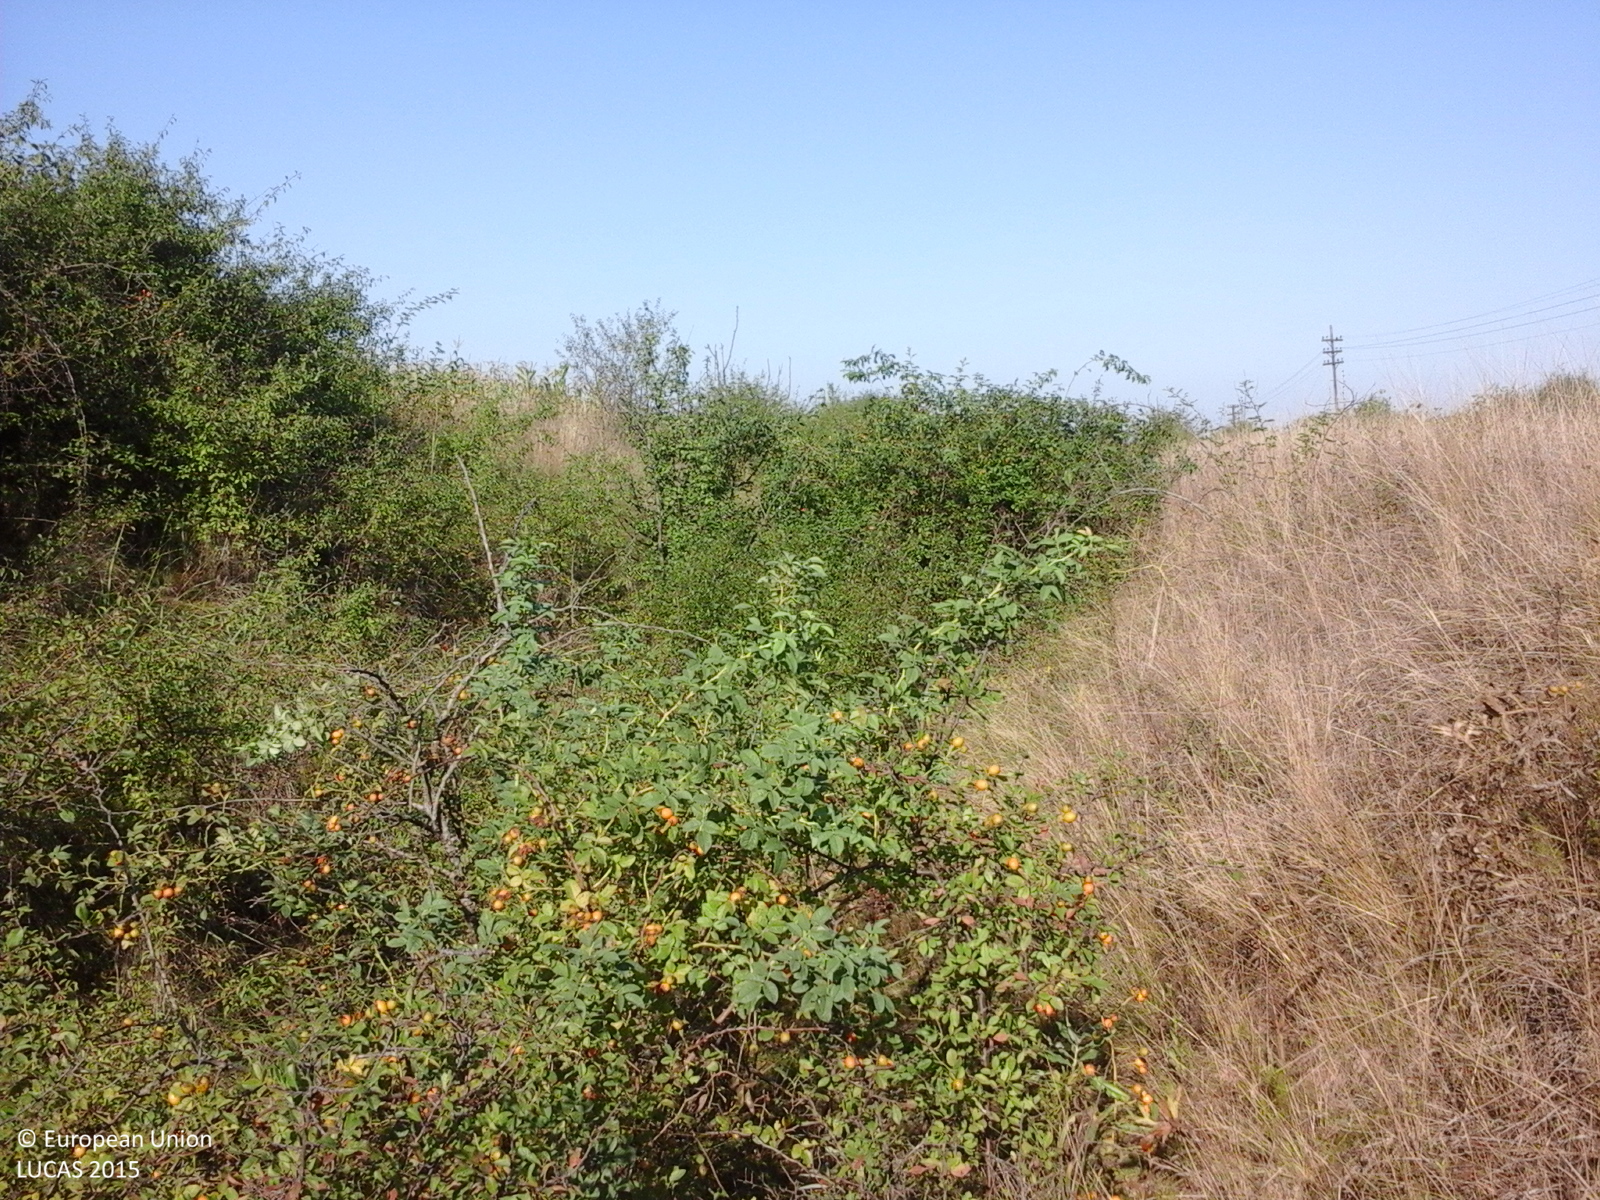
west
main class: Grassland
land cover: Spontaneously vegetated surfaces
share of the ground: > 75 %
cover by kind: herbaceous plants 100 %
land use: Semi-natural and natural areas not in use
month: August
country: RO
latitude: 45.6965
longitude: 21.2938
